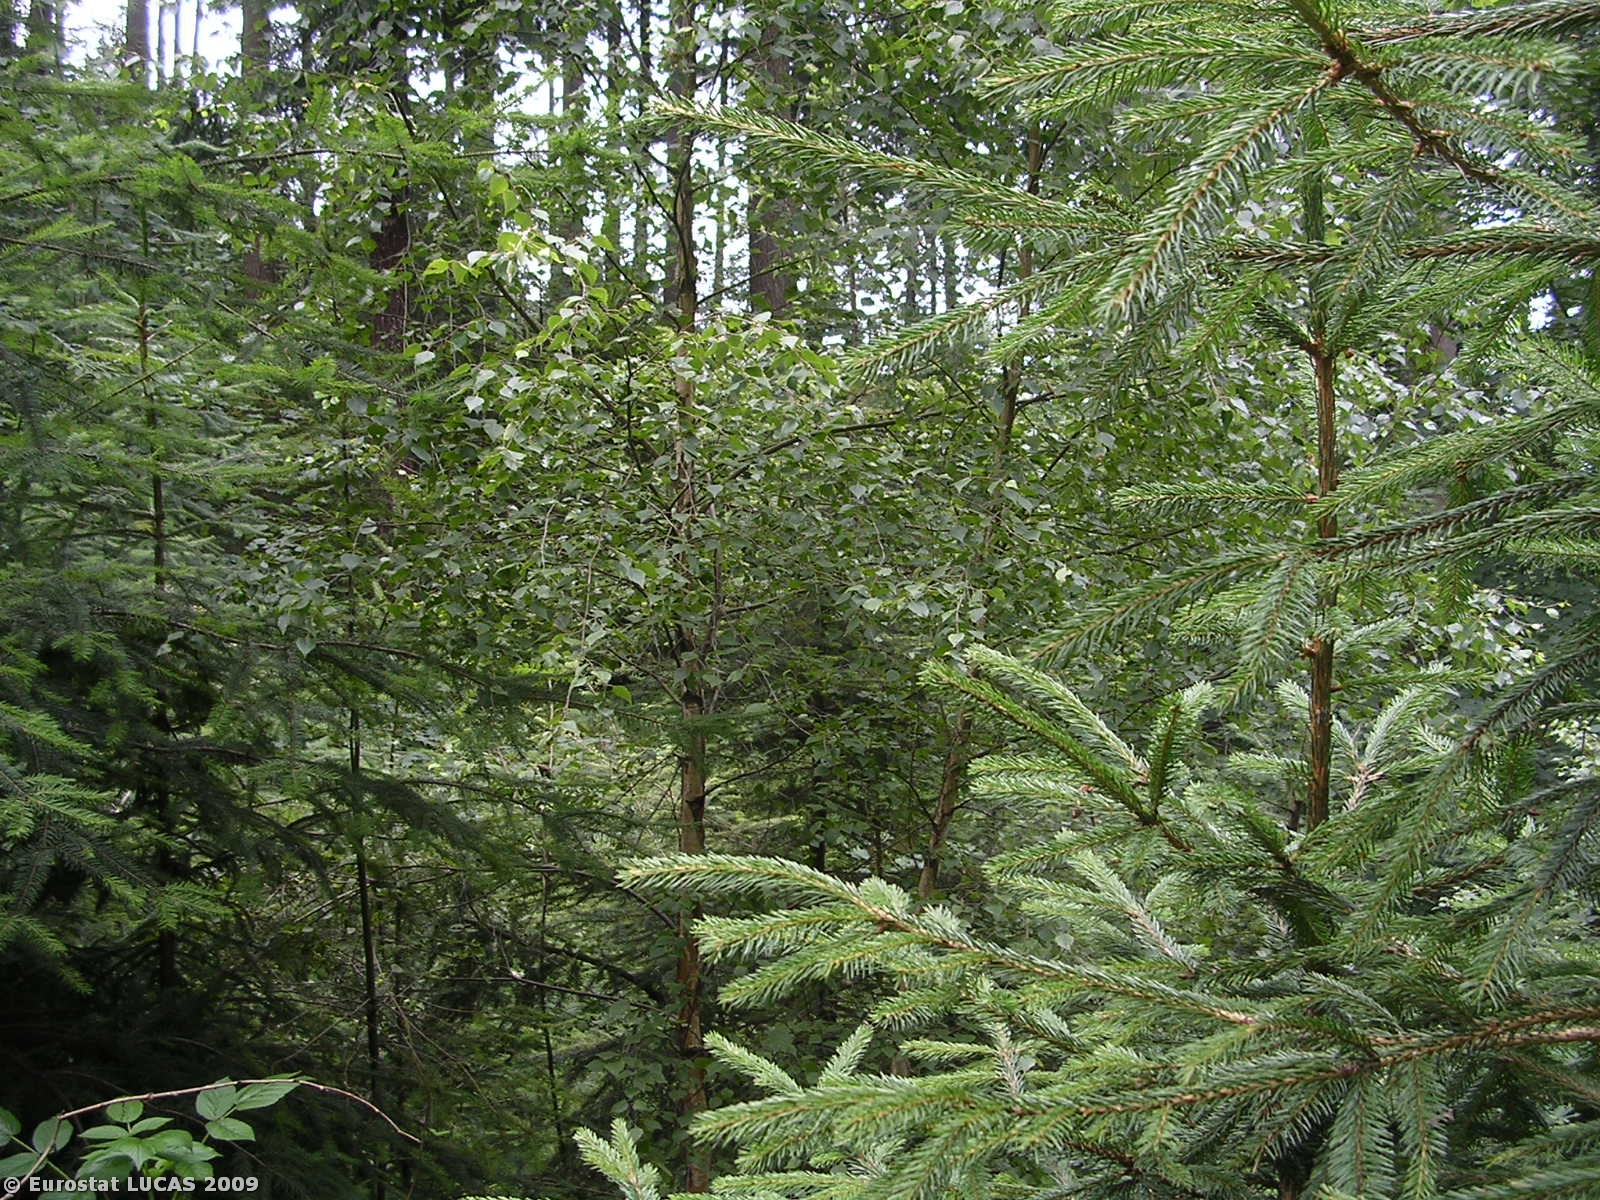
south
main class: Woodland
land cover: Mixed woodland
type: hemiboreal forest and nemoral coniferous forest and mixed broadleaved-coniferous forest
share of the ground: > 75 %
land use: Forestry
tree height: > 5 m
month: July
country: CZ
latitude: 50.7910
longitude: 15.0959
